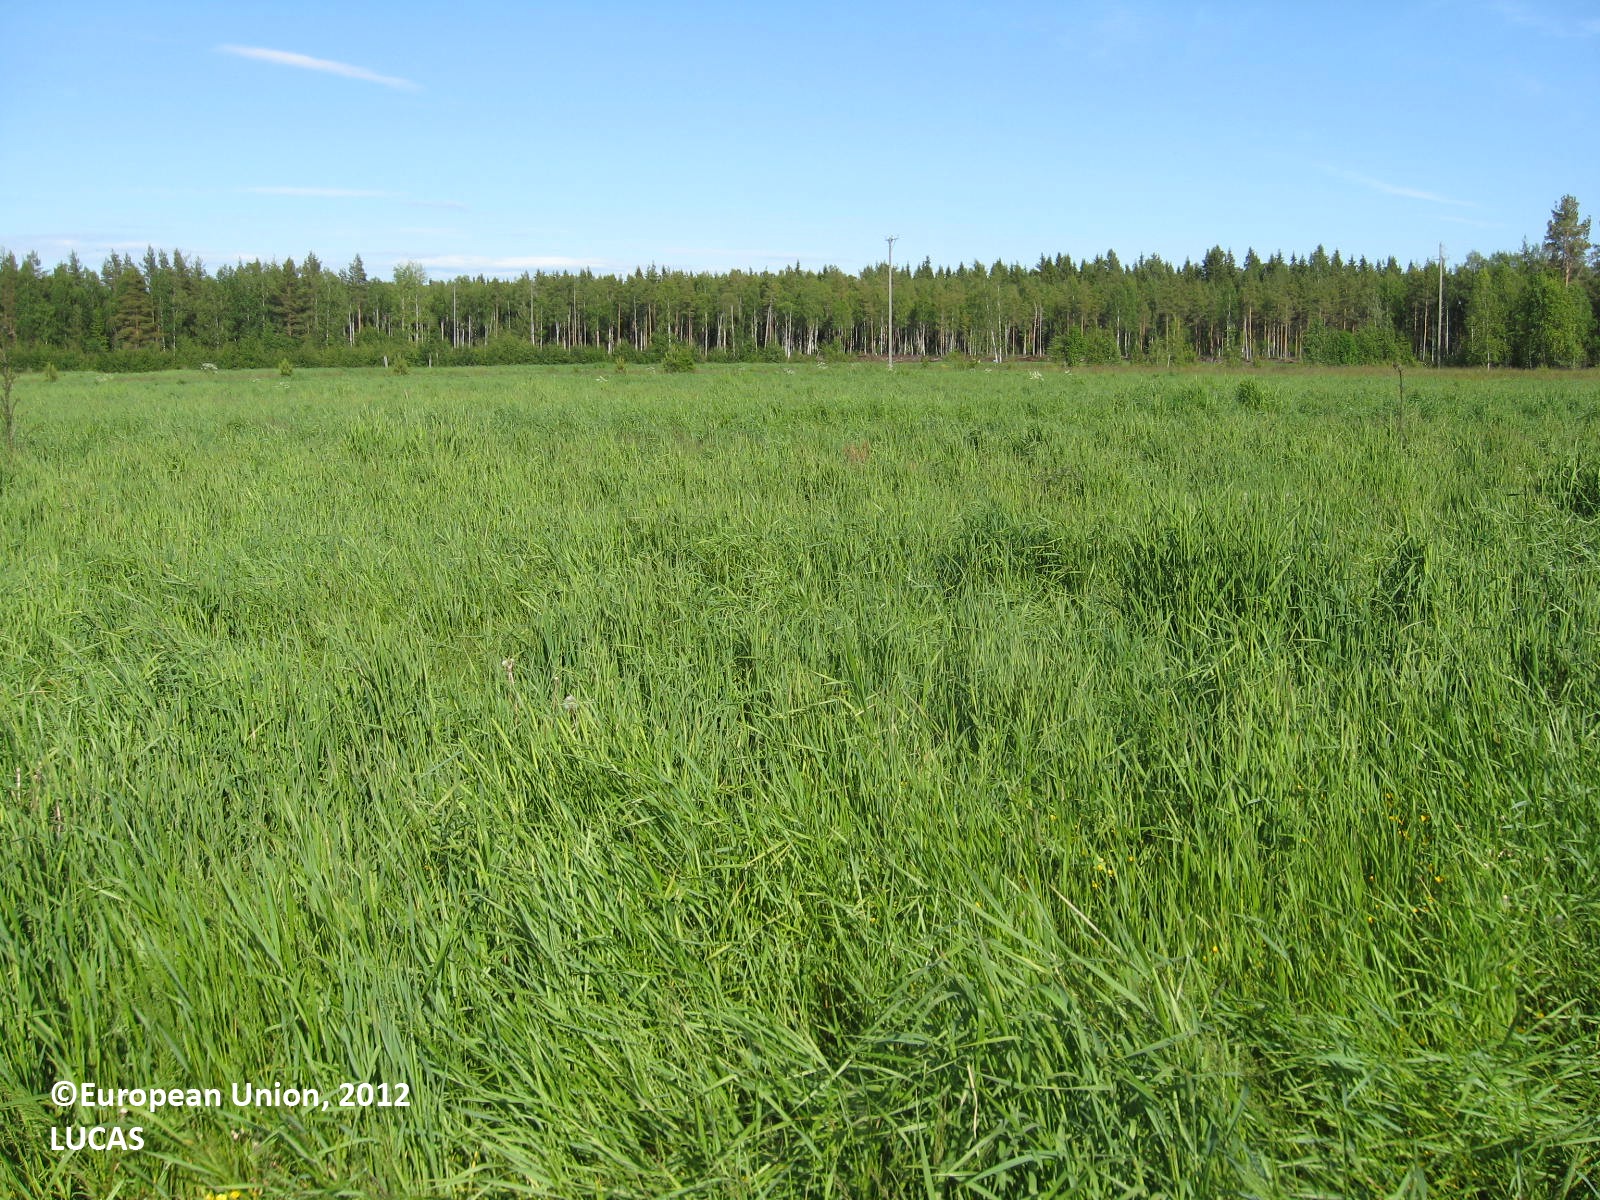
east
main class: Cropland
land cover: Temporary grasslands
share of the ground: > 75 %
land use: Agriculture (excluding fallow land and kitchen gardens)
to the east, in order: Temporary grasslands; Electric lines; Ditches and canals; Shruby margins; Tracks; Shruby margins; Ditches and canals; Temporary grasslands; Ditches and canals; Temporary grasslands; Ditches and canals; Temporary grasslands; Ditches and canals; Temporary grasslands; Ditches and canals; Lines of trees; Oats; Ditches and canals; Other bare soil
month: June
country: FI
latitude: 62.6484
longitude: 21.6915
